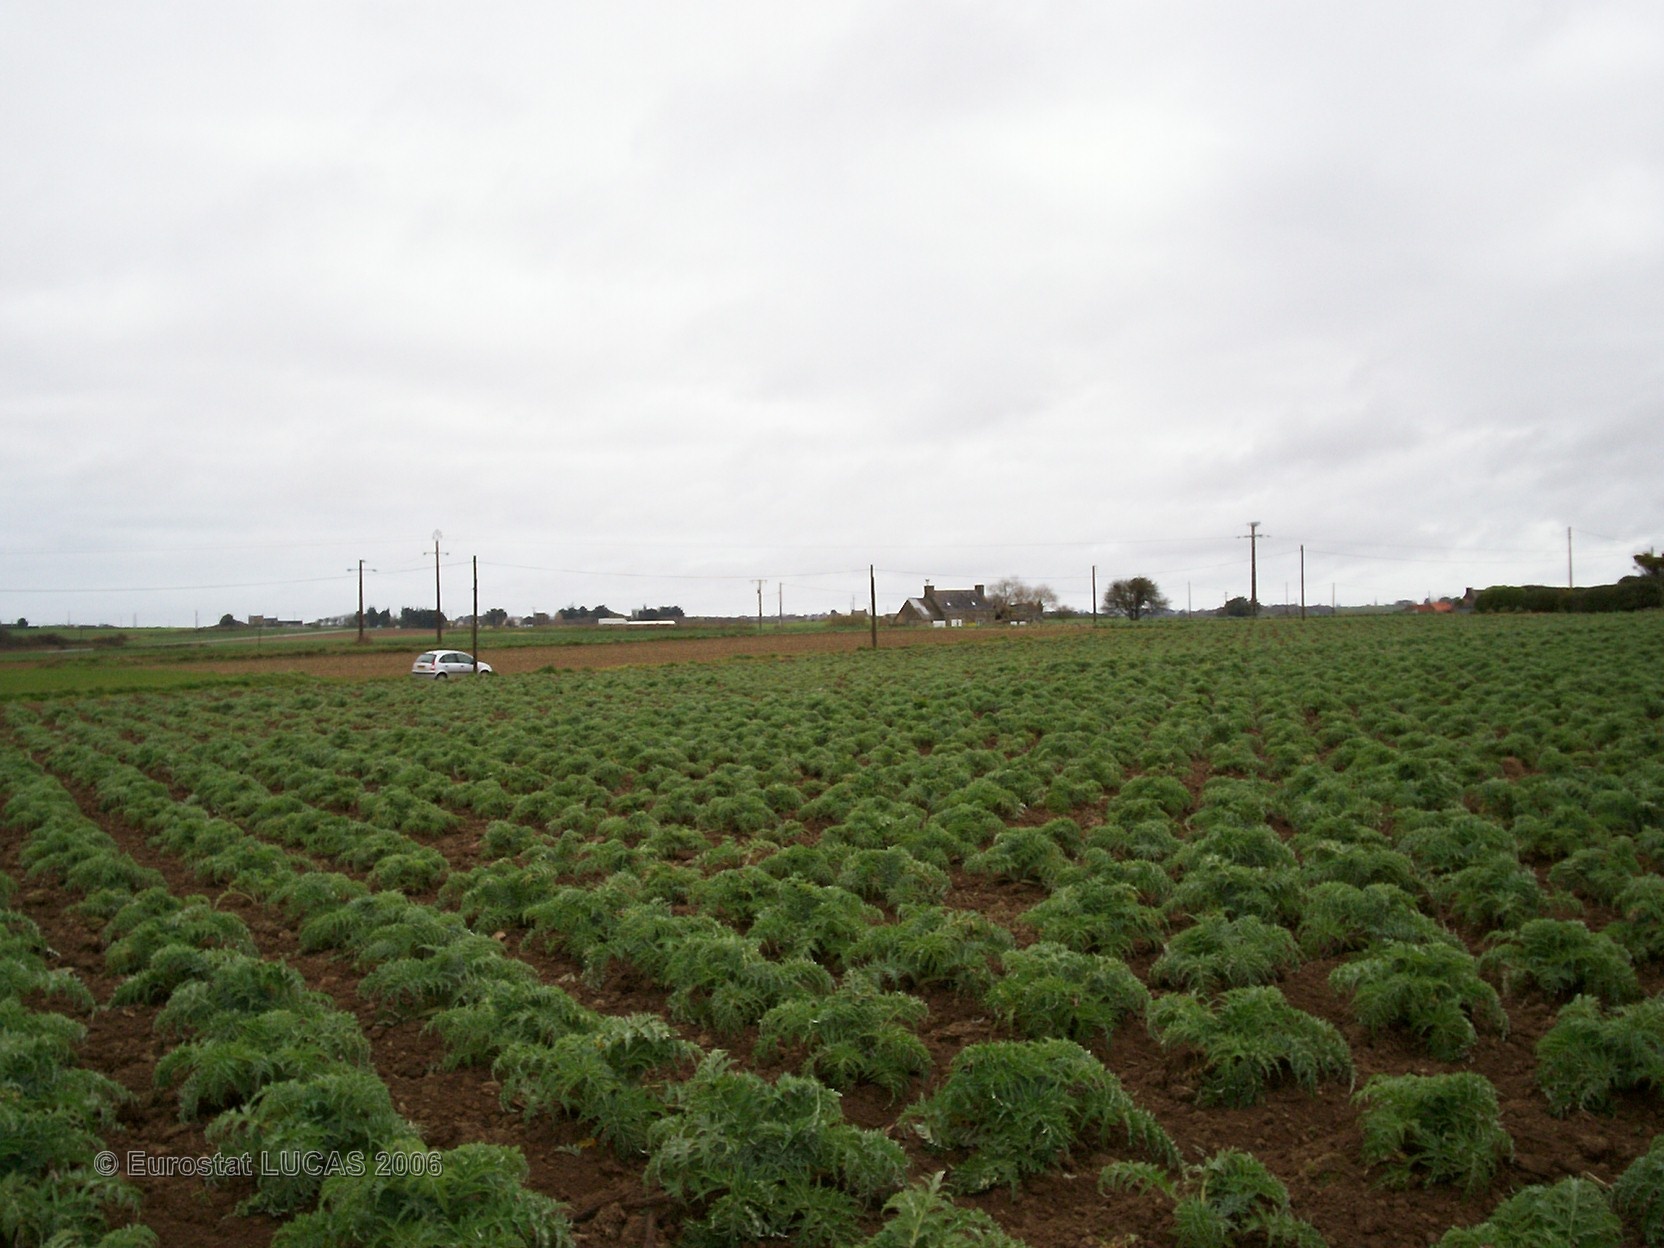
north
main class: Cropland
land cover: Other fresh vegetables
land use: Agriculture (excluding fallow land and kitchen gardens)
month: April
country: FR
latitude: 48.6326
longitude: -4.0529
